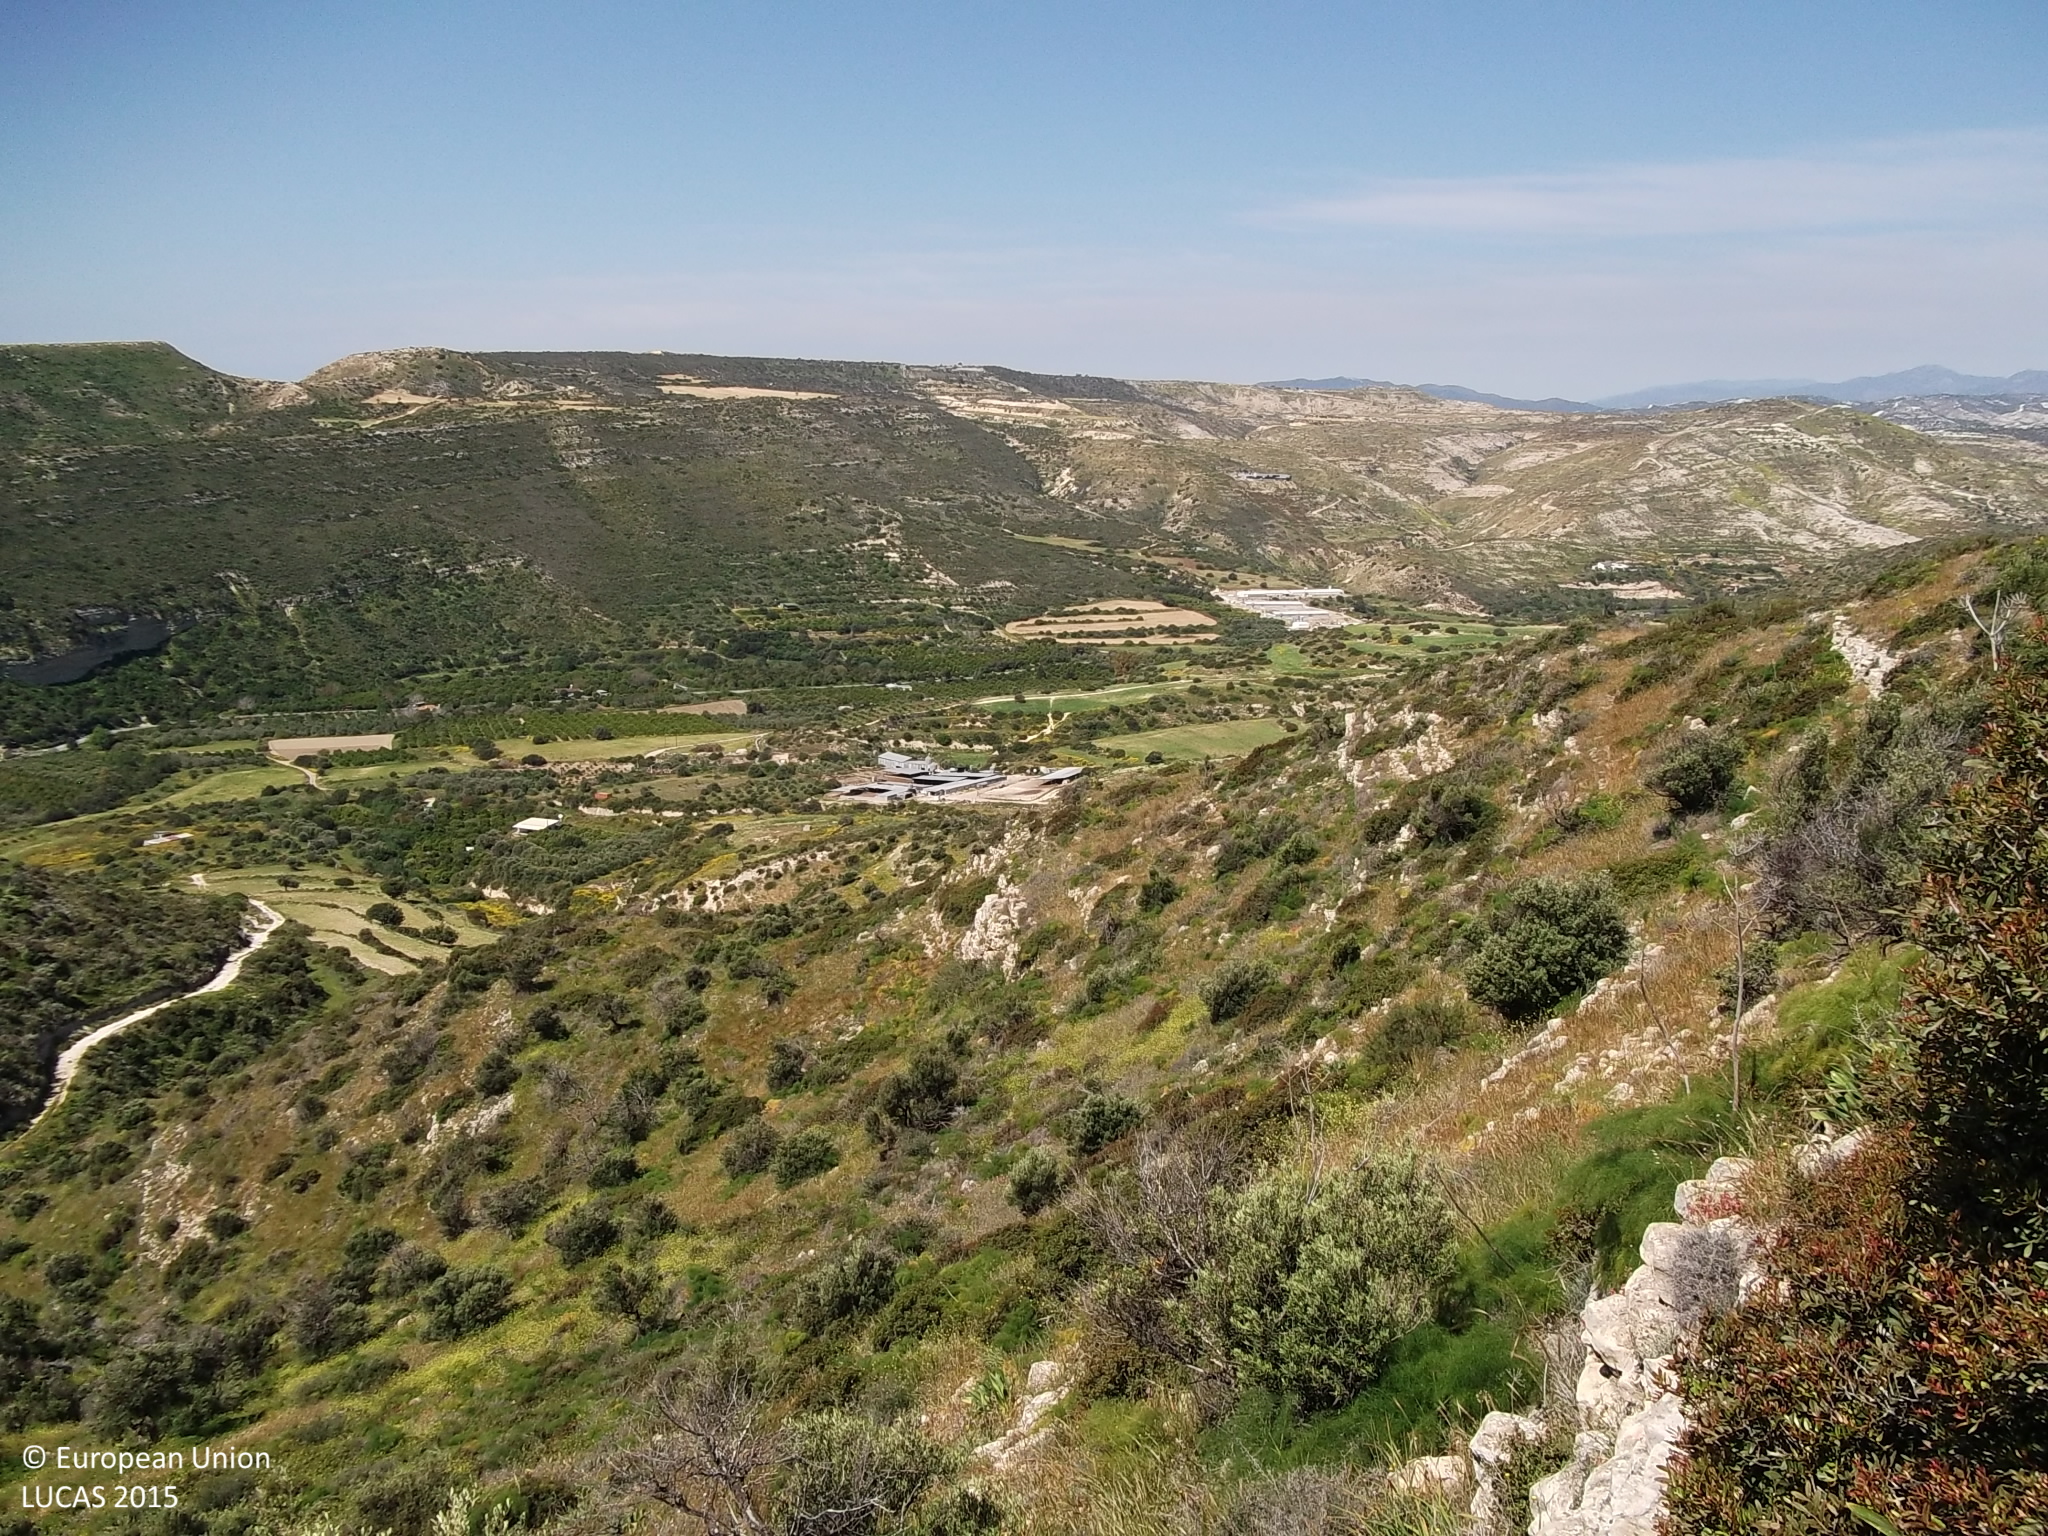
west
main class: Shrubland
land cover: Shrubland with sparse tree cover
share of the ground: 50 - 75 %
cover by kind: shrubs 45 %, herbaceous plants 40 %, unconsolidated bare surface 10 %, broadleaved forest trees 5 %
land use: Semi-natural and natural areas not in use
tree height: < 5 m
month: April
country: CY
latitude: 34.7833
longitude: 33.4046
